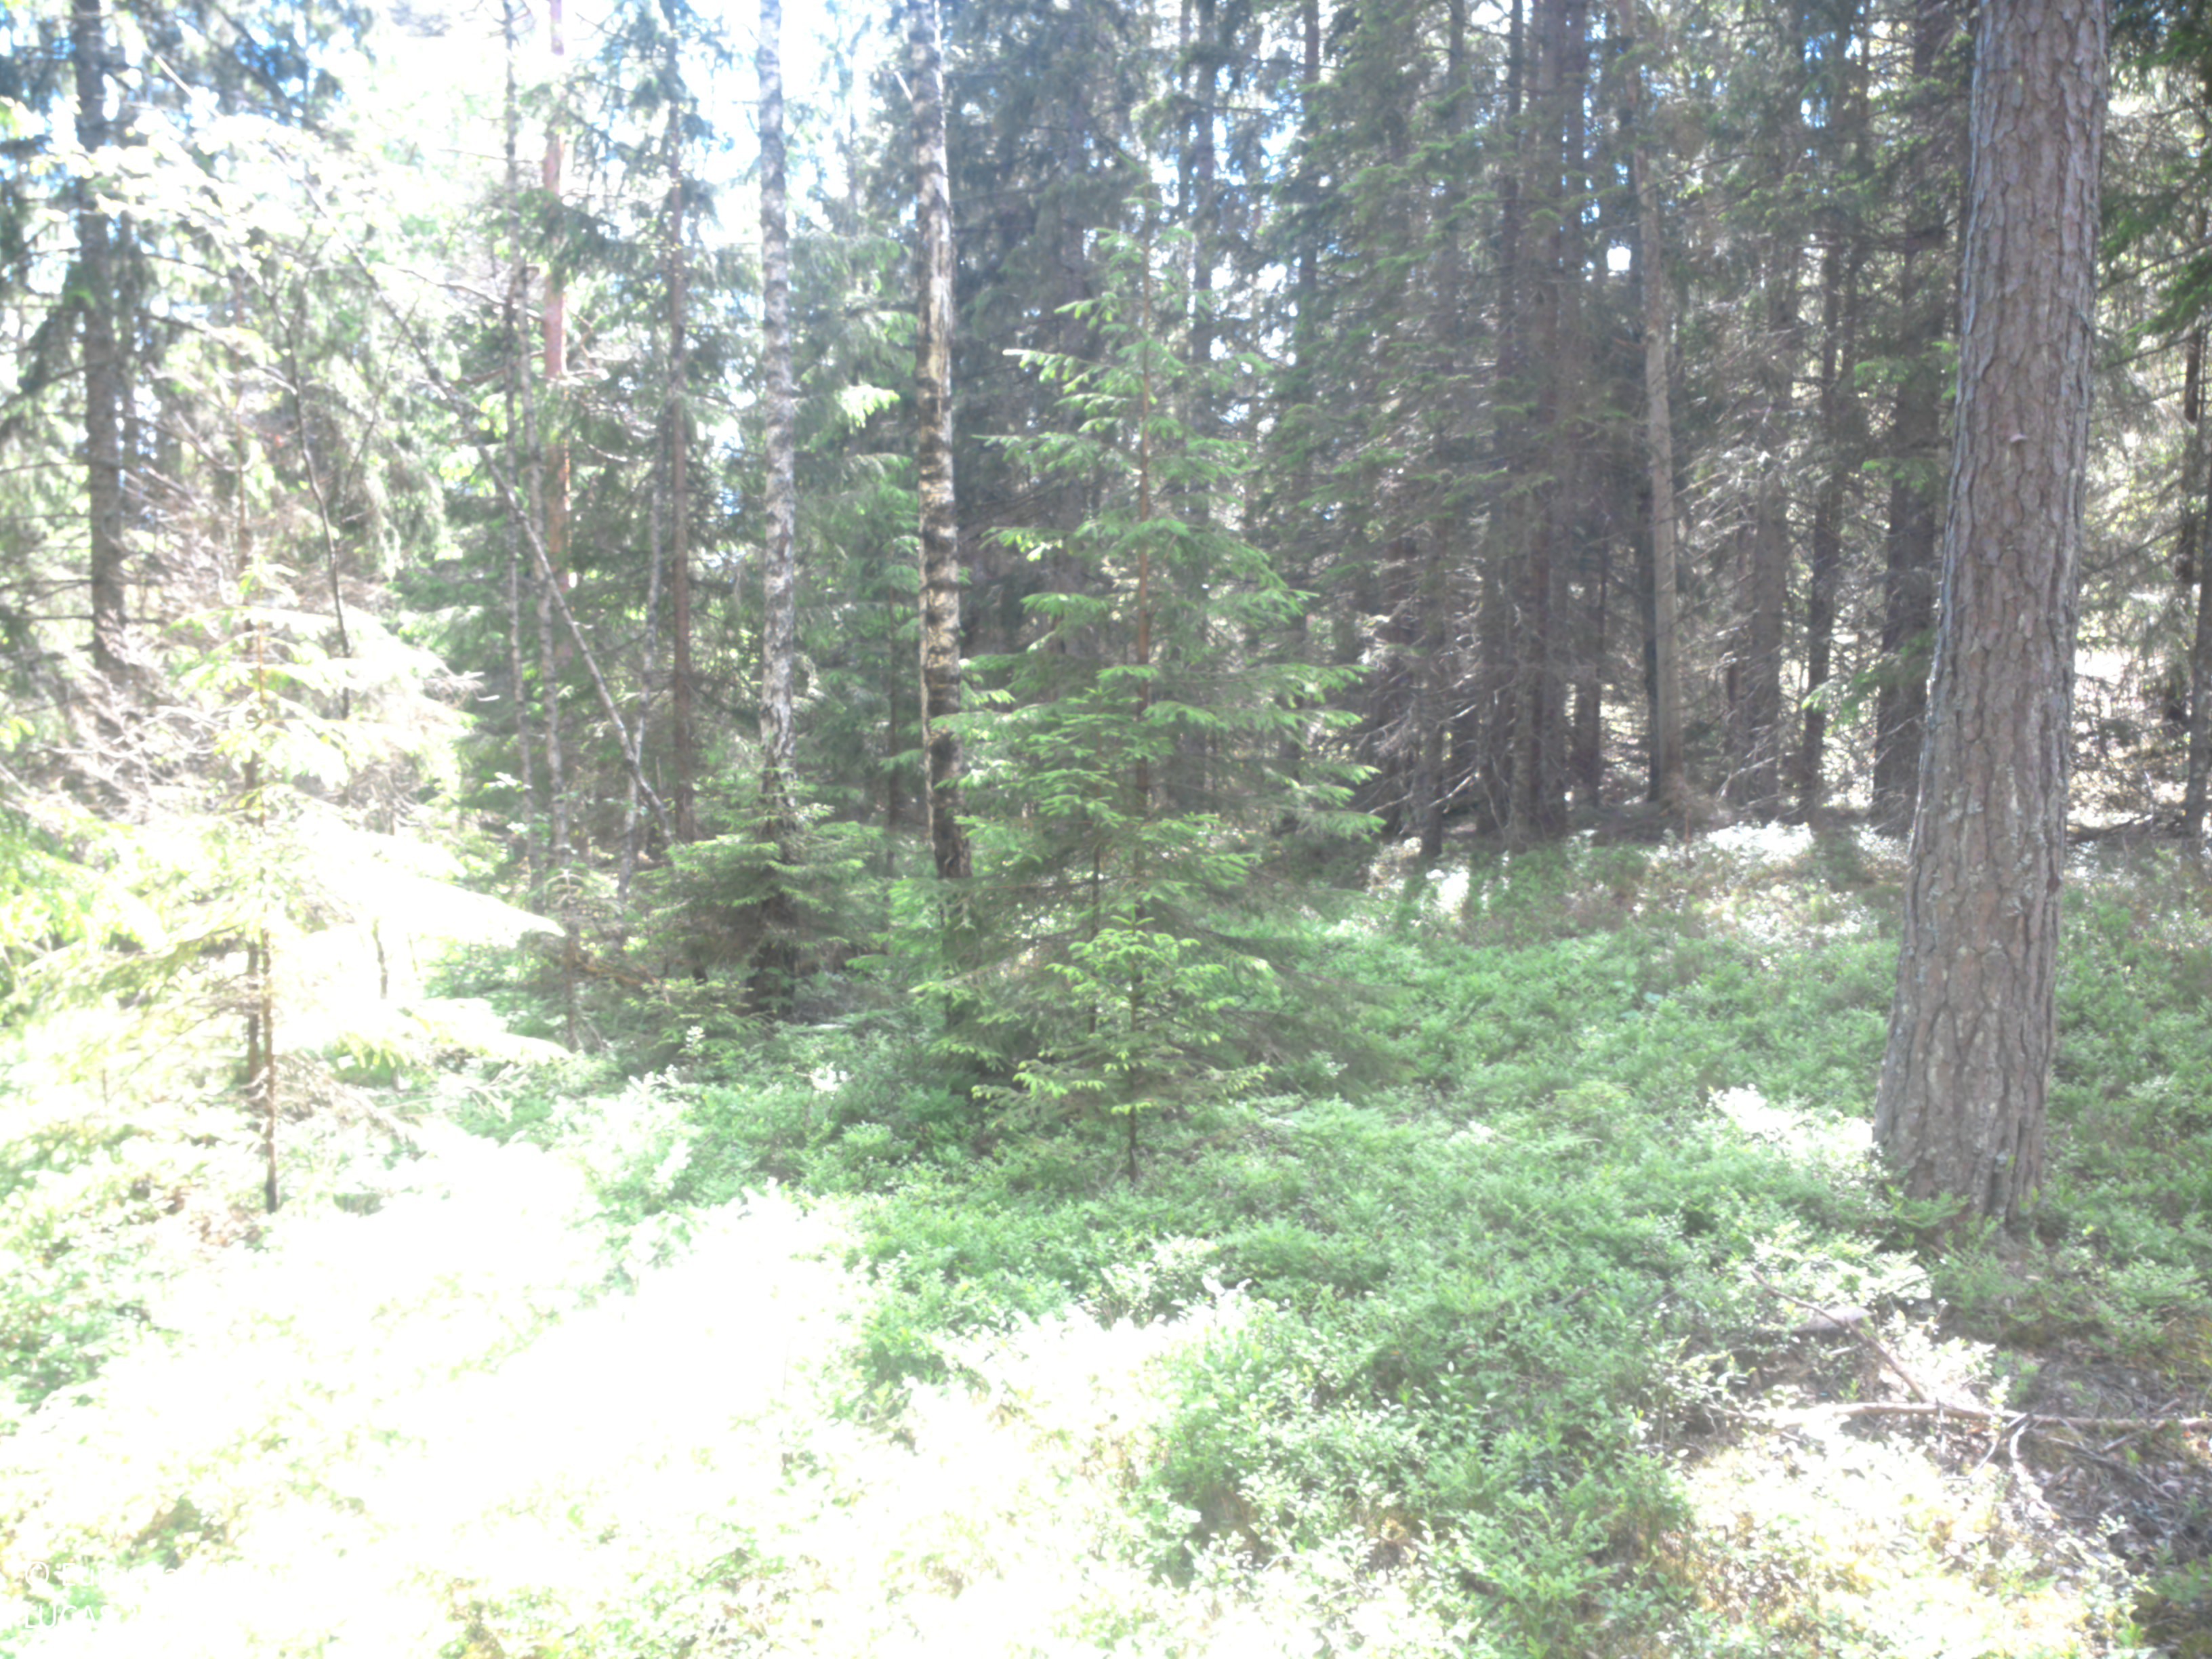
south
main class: Woodland
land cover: Other mixed woodland
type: boreal forest
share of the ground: 50 - 75 %
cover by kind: coniferous forest trees 40 %, herbaceous plants 25 %, broadleaved forest trees 15 %, shrubs 15 %, lichens and mosses 5 %
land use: Forestry
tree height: > 5 m
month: June
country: SE
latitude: 59.0528
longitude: 11.8262
